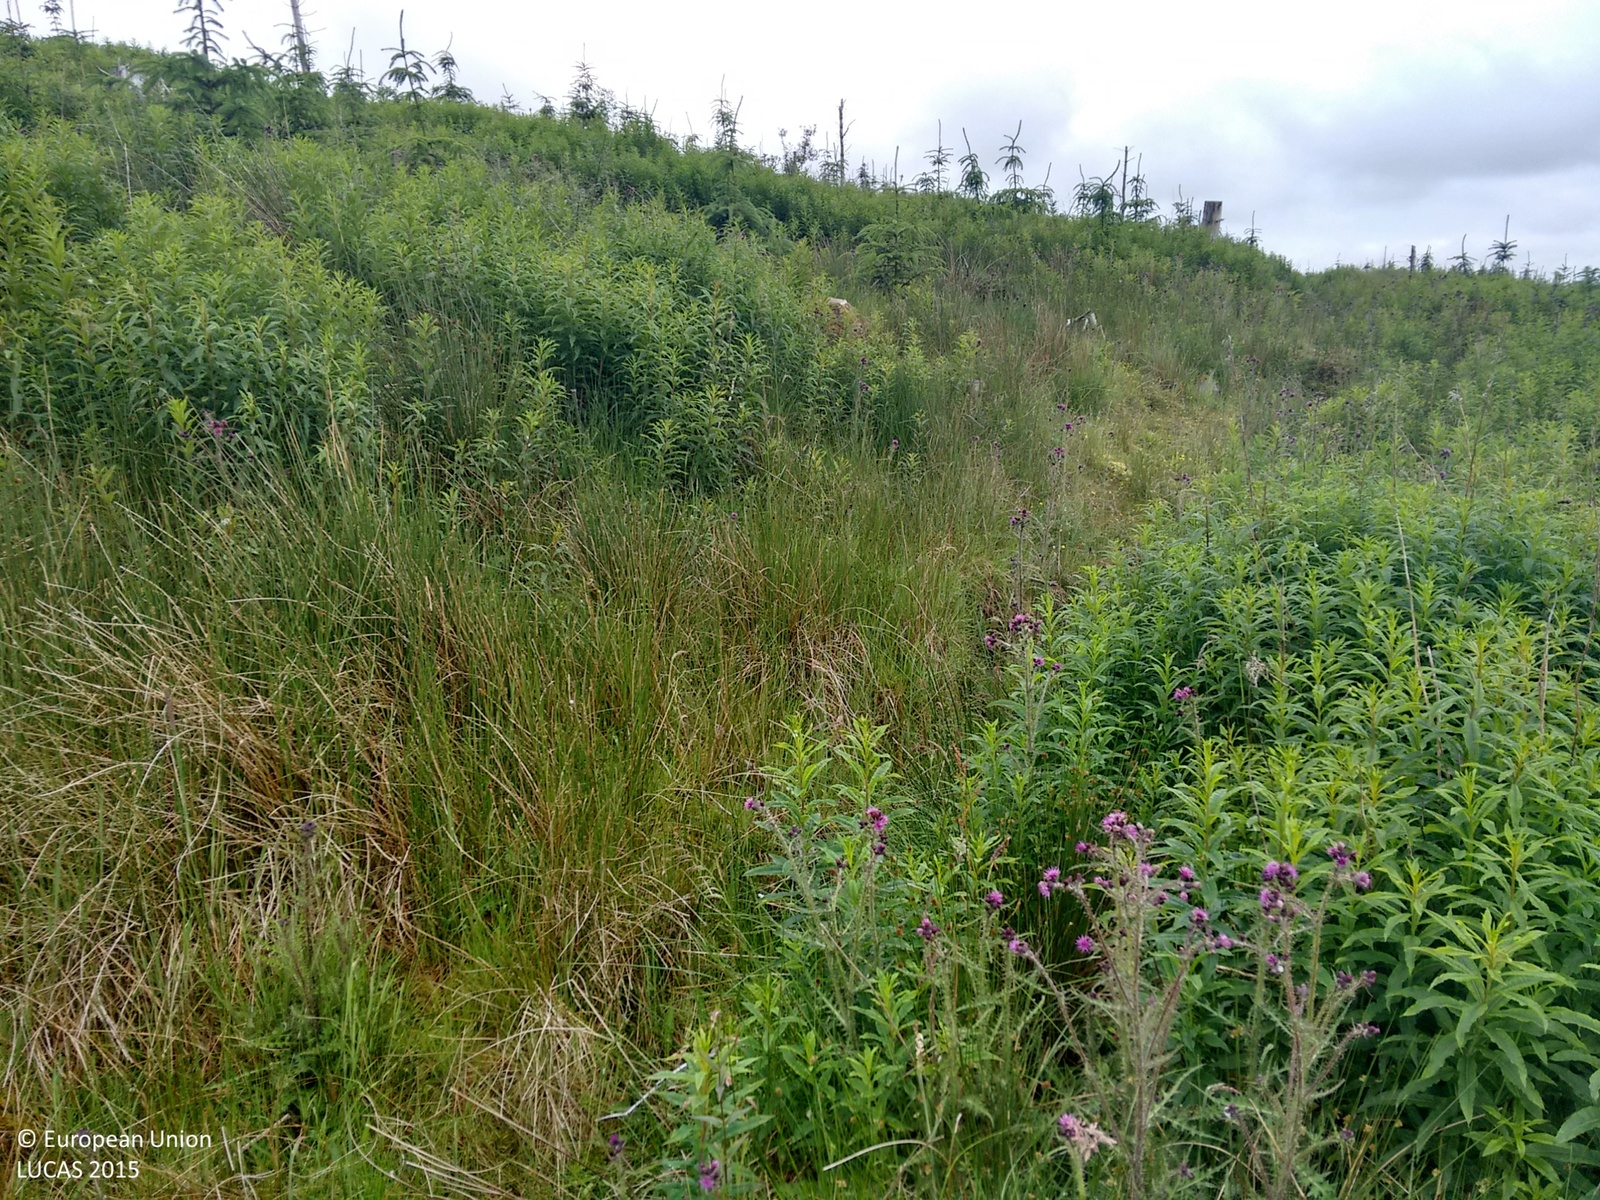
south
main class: Woodland
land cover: Spruce dominated coniferous woodland
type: exotic forest
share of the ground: 10 - 25 %
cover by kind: herbaceous plants 80 %, coniferous forest trees 15 %, shrubs 5 %
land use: Forestry
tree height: < 5 m
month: July
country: GB
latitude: 55.2738
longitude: -4.2781
